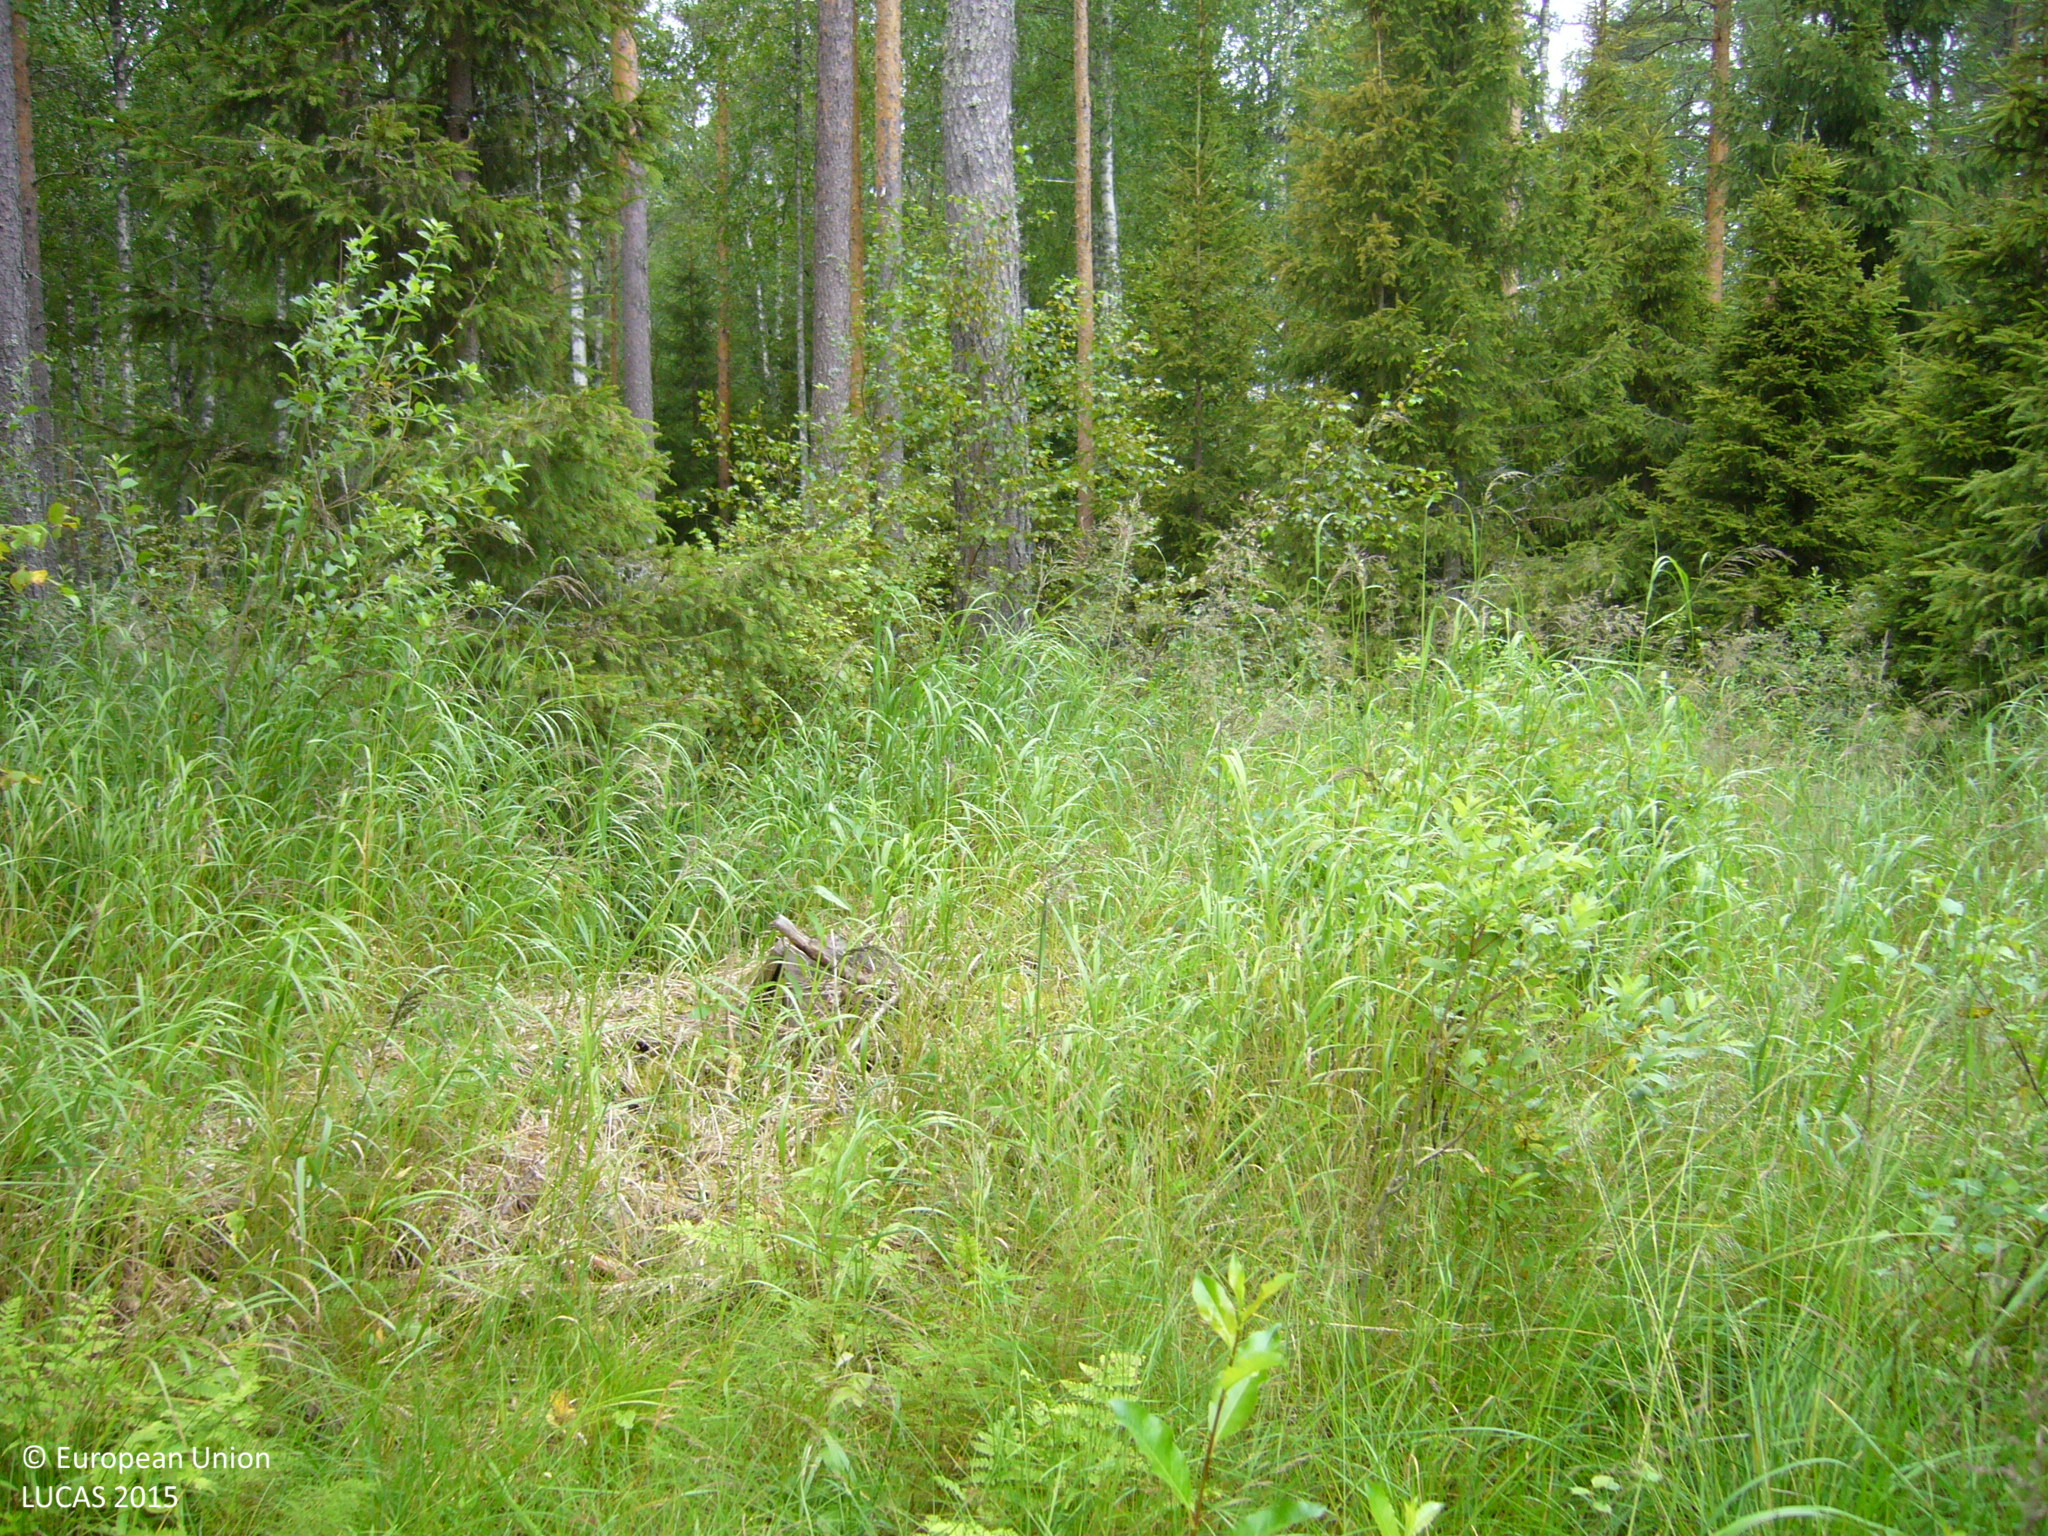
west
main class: Woodland
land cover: Spruce dominated mixed woodland
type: boreal forest
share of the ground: 50 - 75 %
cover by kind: coniferous forest trees 40 %, broadleaved forest trees 30 %, shrubs 30 %
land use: Forestry
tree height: > 5 m
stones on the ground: < 10 %
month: July
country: FI
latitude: 64.1391
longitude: 25.9474
